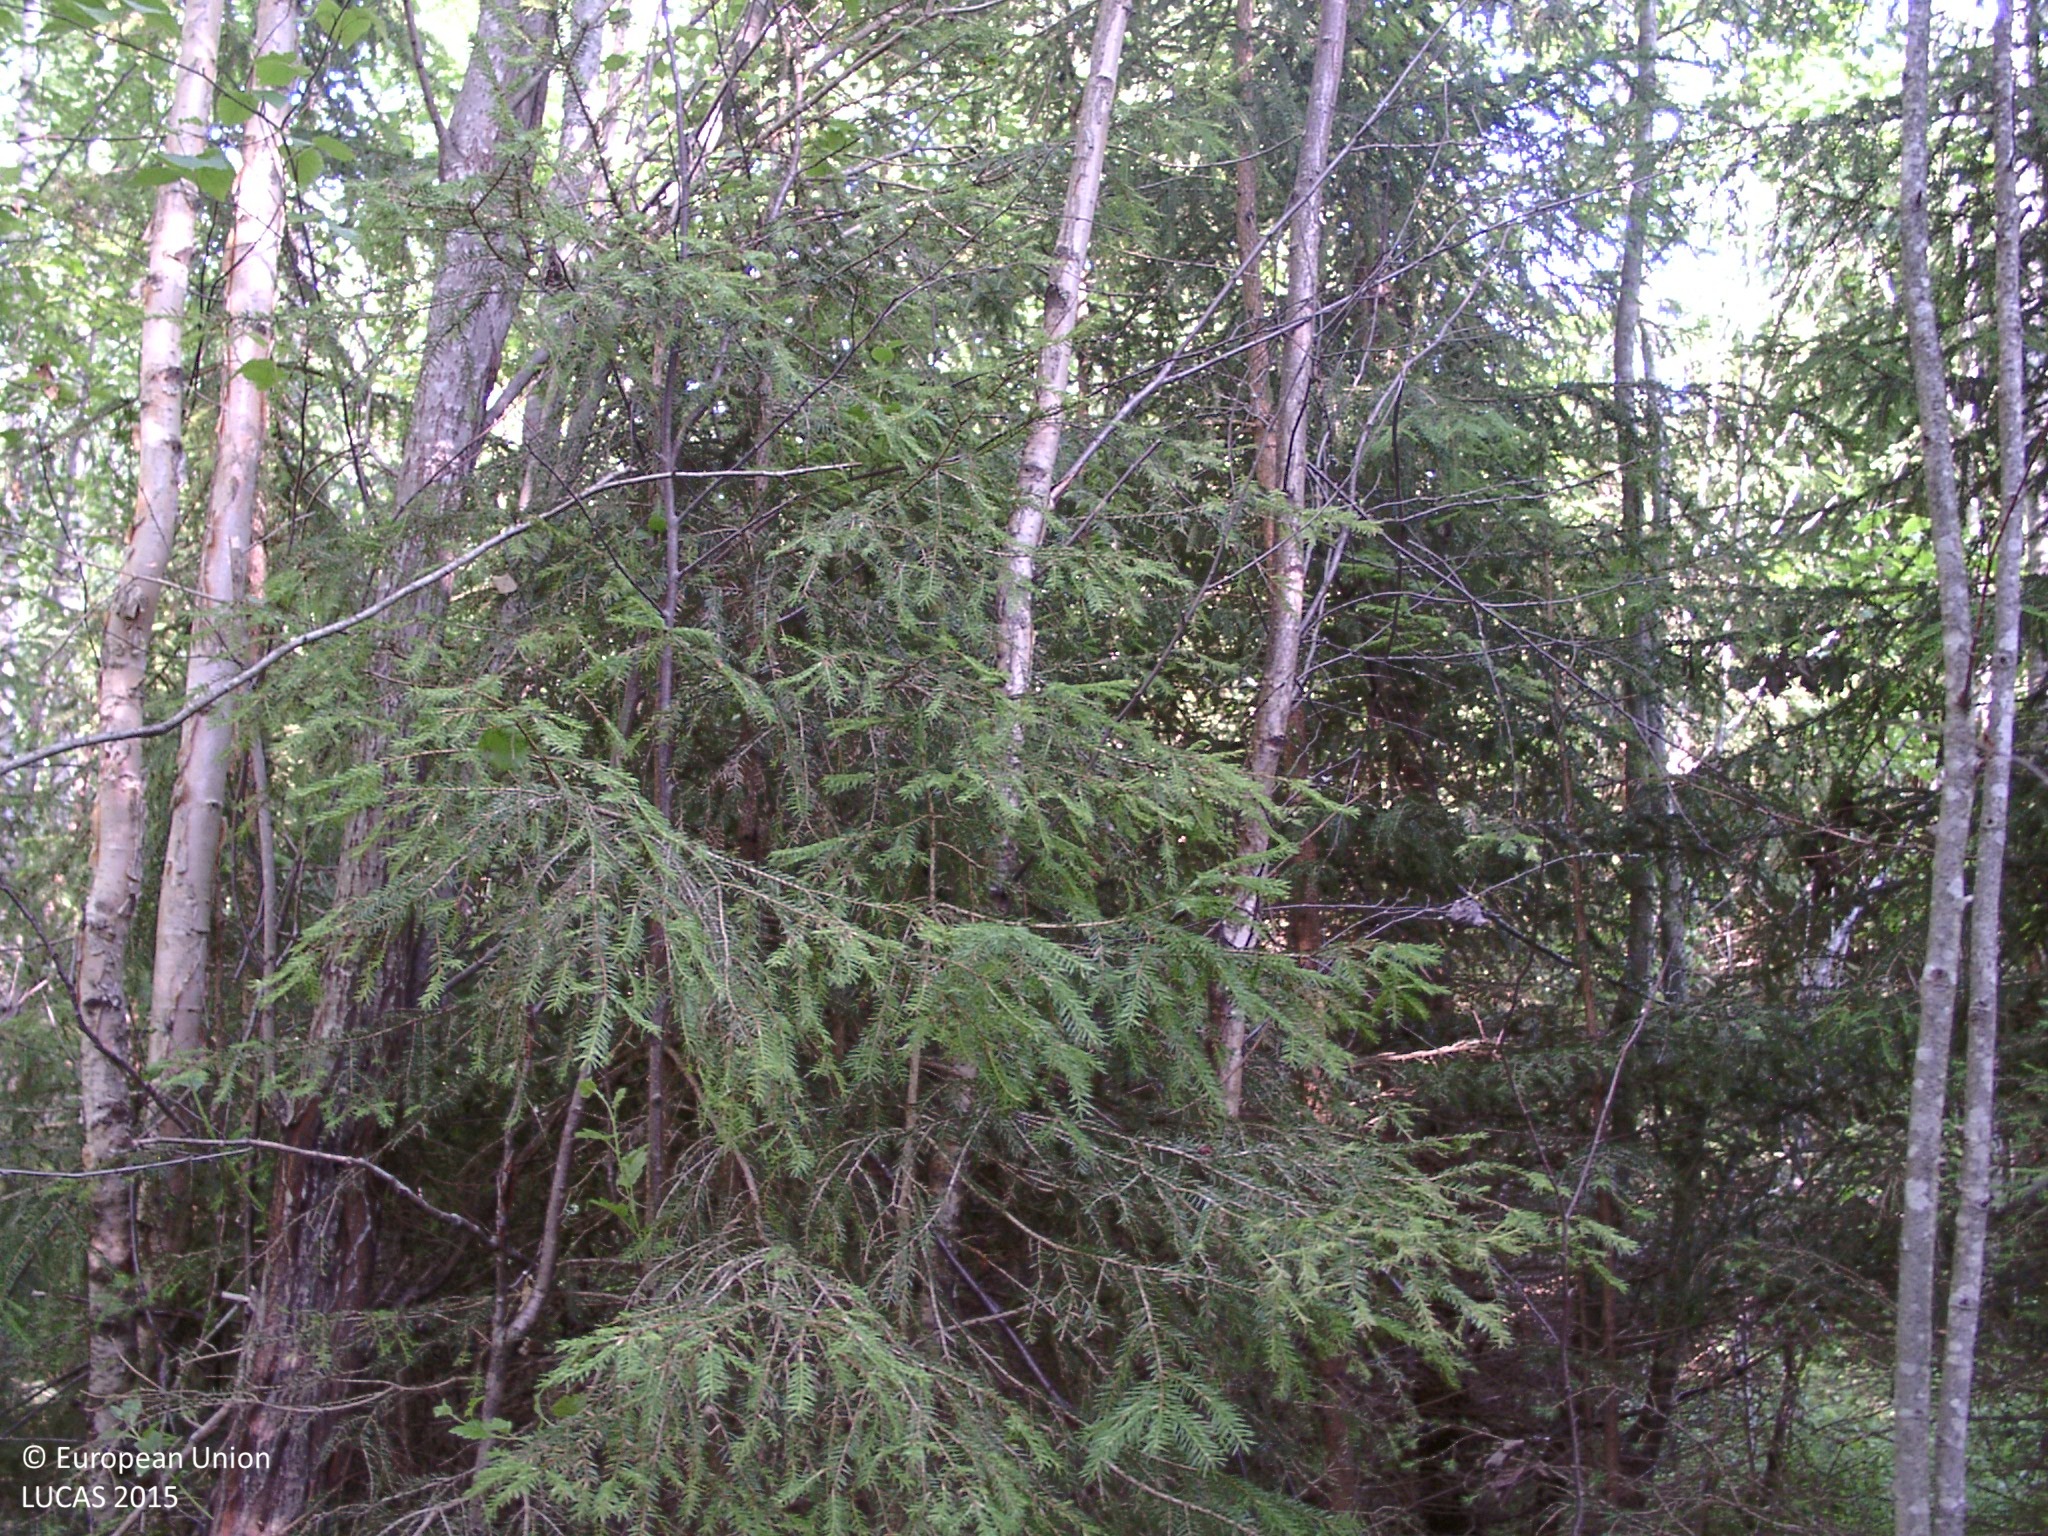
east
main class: Woodland
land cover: Spruce dominated mixed woodland
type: boreal forest
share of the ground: > 75 %
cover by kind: broadleaved forest trees 60 %, coniferous forest trees 25 %, herbaceous plants 10 %, unconsolidated bare surface 5 %
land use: Forestry
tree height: > 5 m
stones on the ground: < 10 %
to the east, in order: Spruce dominated mixed woodland; Artificial constructions in urban areas; Pine dominated mixed woodland; Inland fresh water bodies
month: July
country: FI
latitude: 61.5860
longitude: 25.2803
